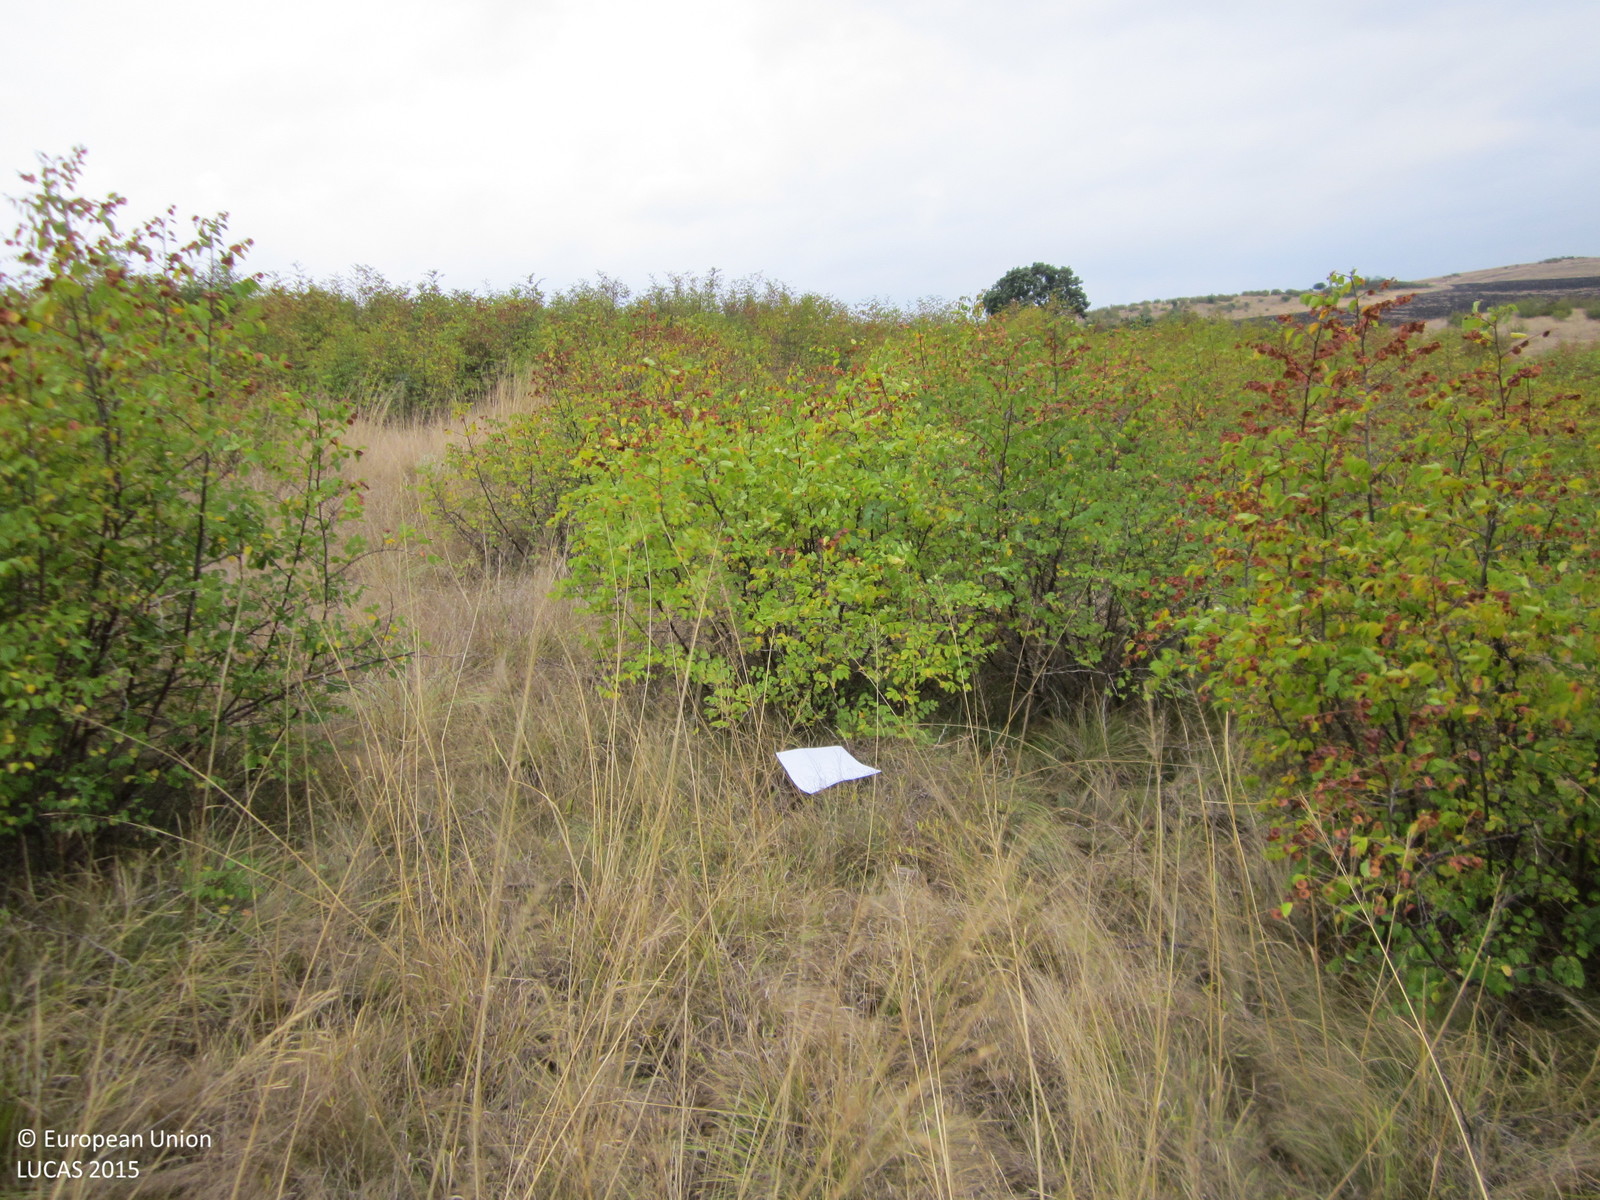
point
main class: Shrubland
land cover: Shrubland without tree cover
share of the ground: 50 - 75 %
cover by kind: shrubs 60 %, herbaceous plants 40 %
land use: Semi-natural and natural areas not in use
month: August
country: BG
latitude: 42.5237
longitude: 27.0388
